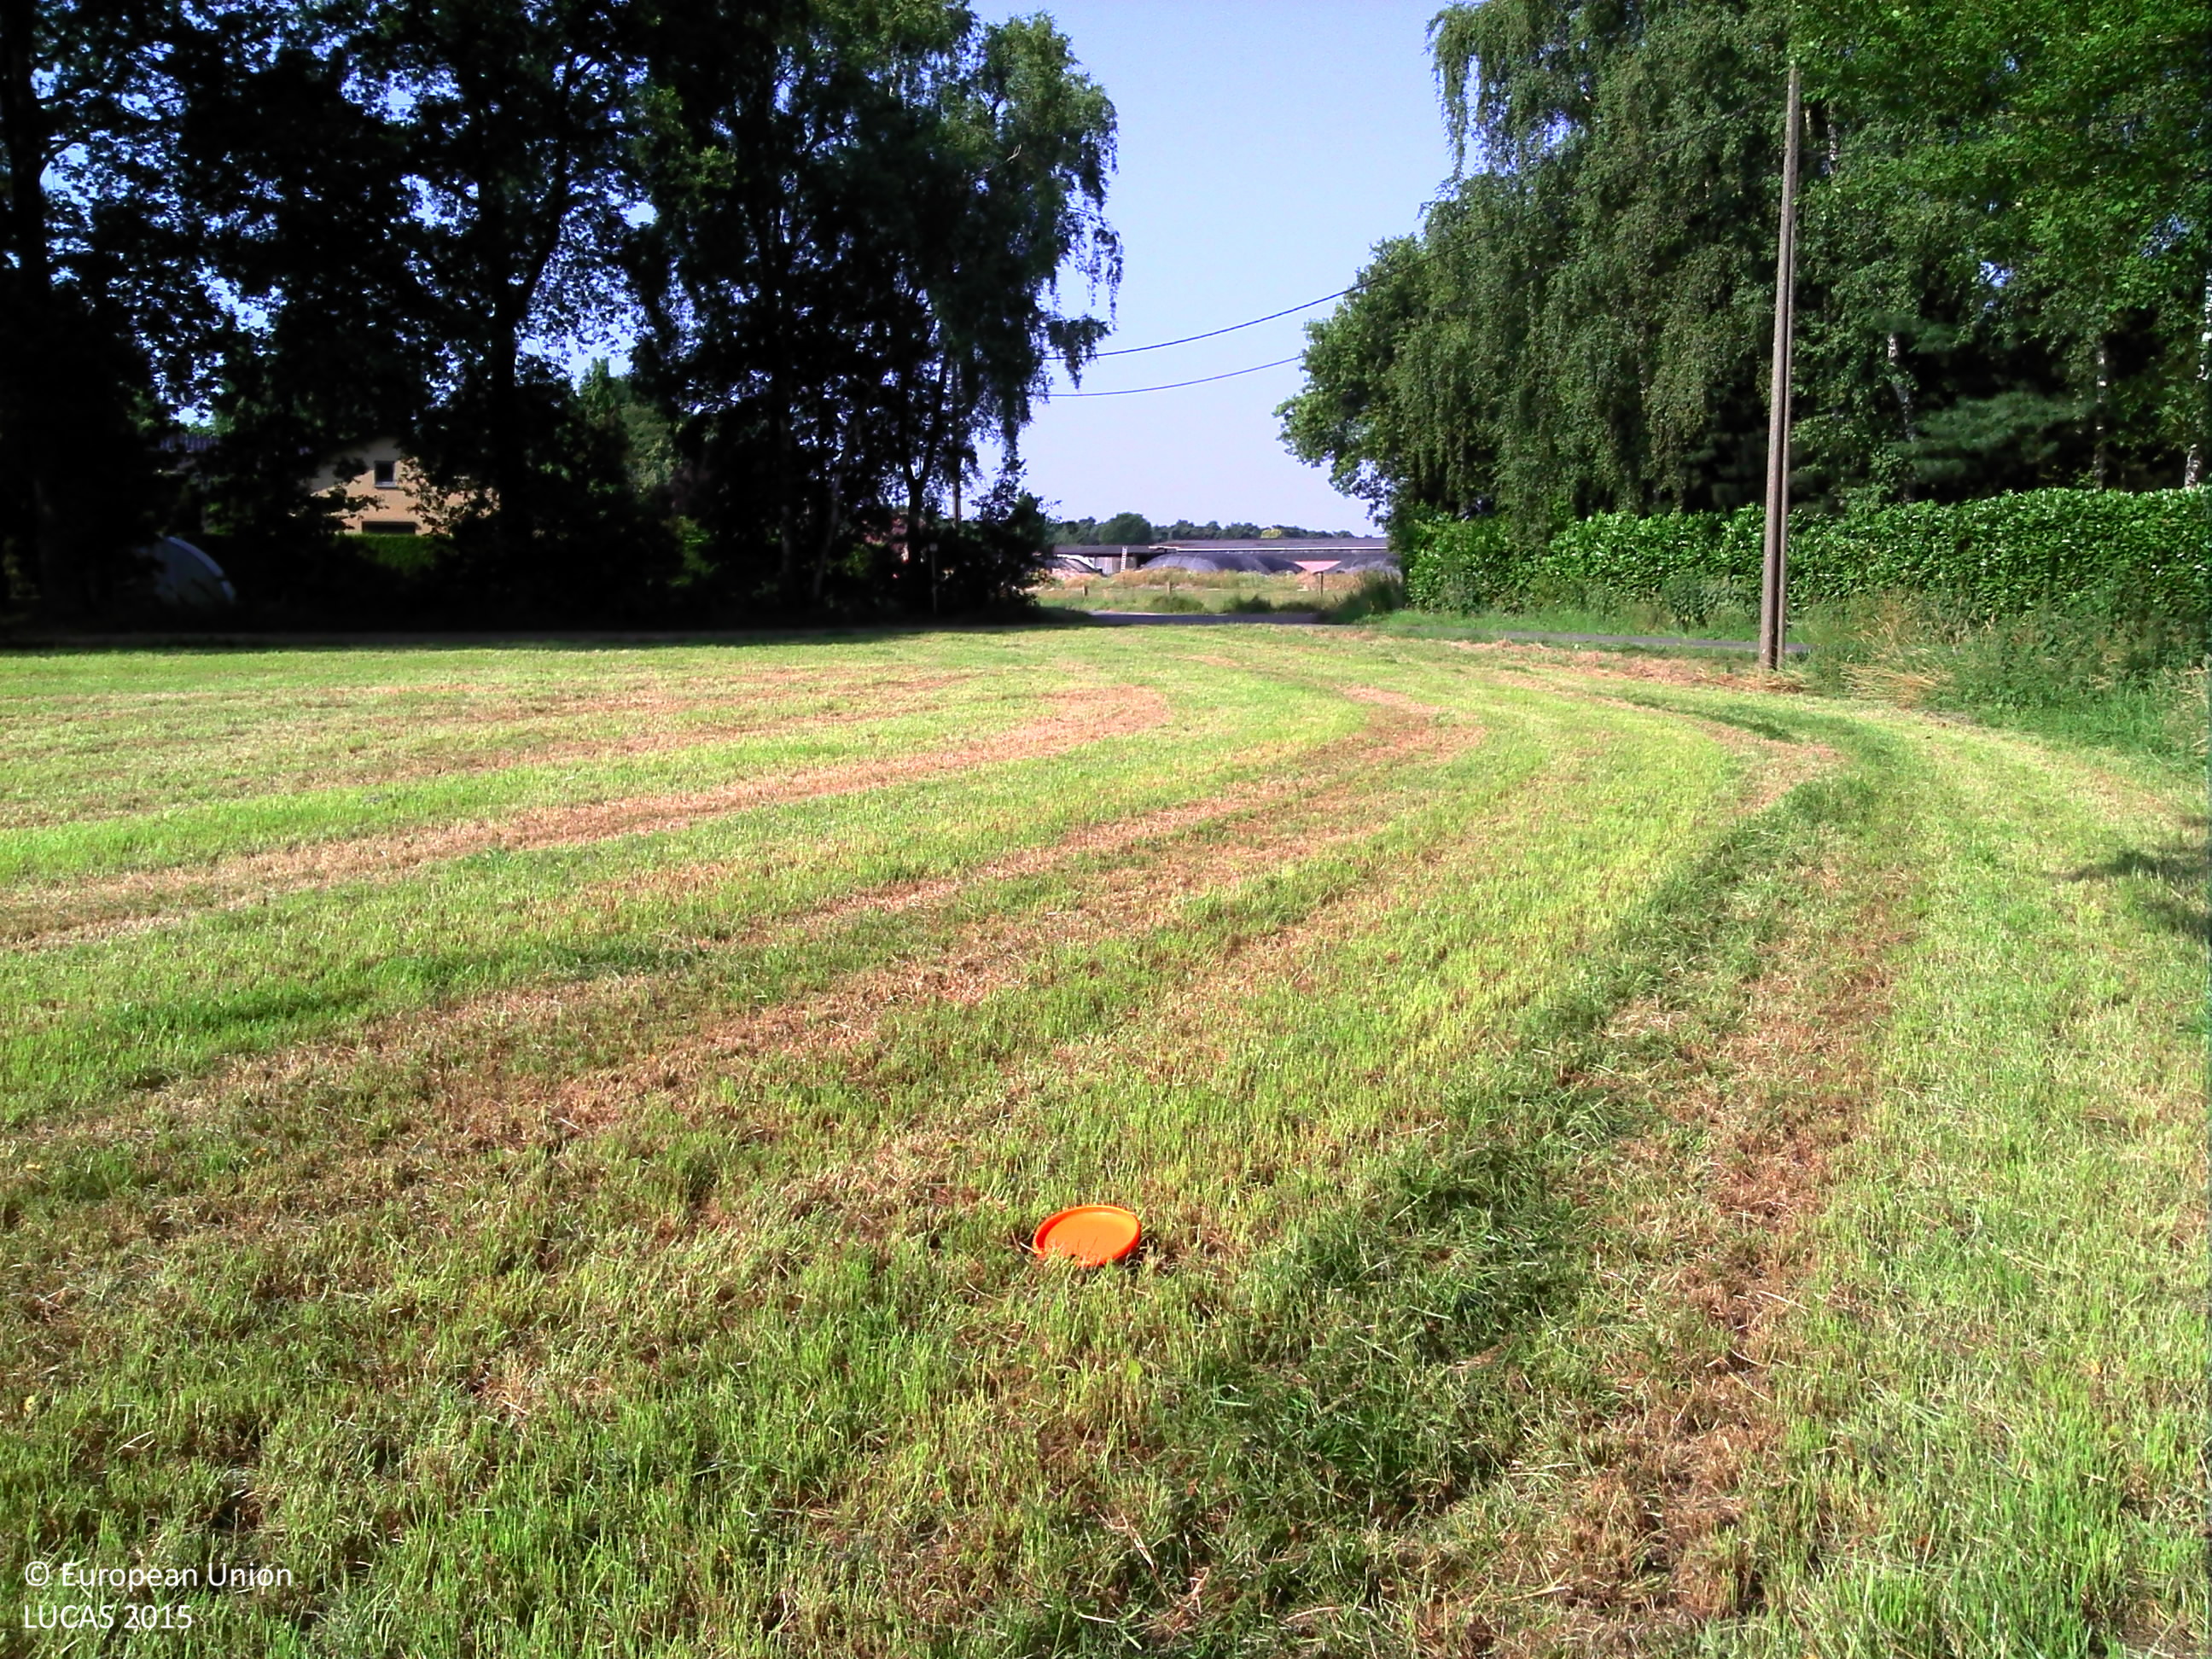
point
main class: Grassland
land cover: Grassland without tree/shrub cover
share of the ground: > 75 %
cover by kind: herbaceous plants 100 %
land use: Agriculture (excluding fallow land and kitchen gardens)
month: July
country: BE
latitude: 51.1039
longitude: 5.4994
